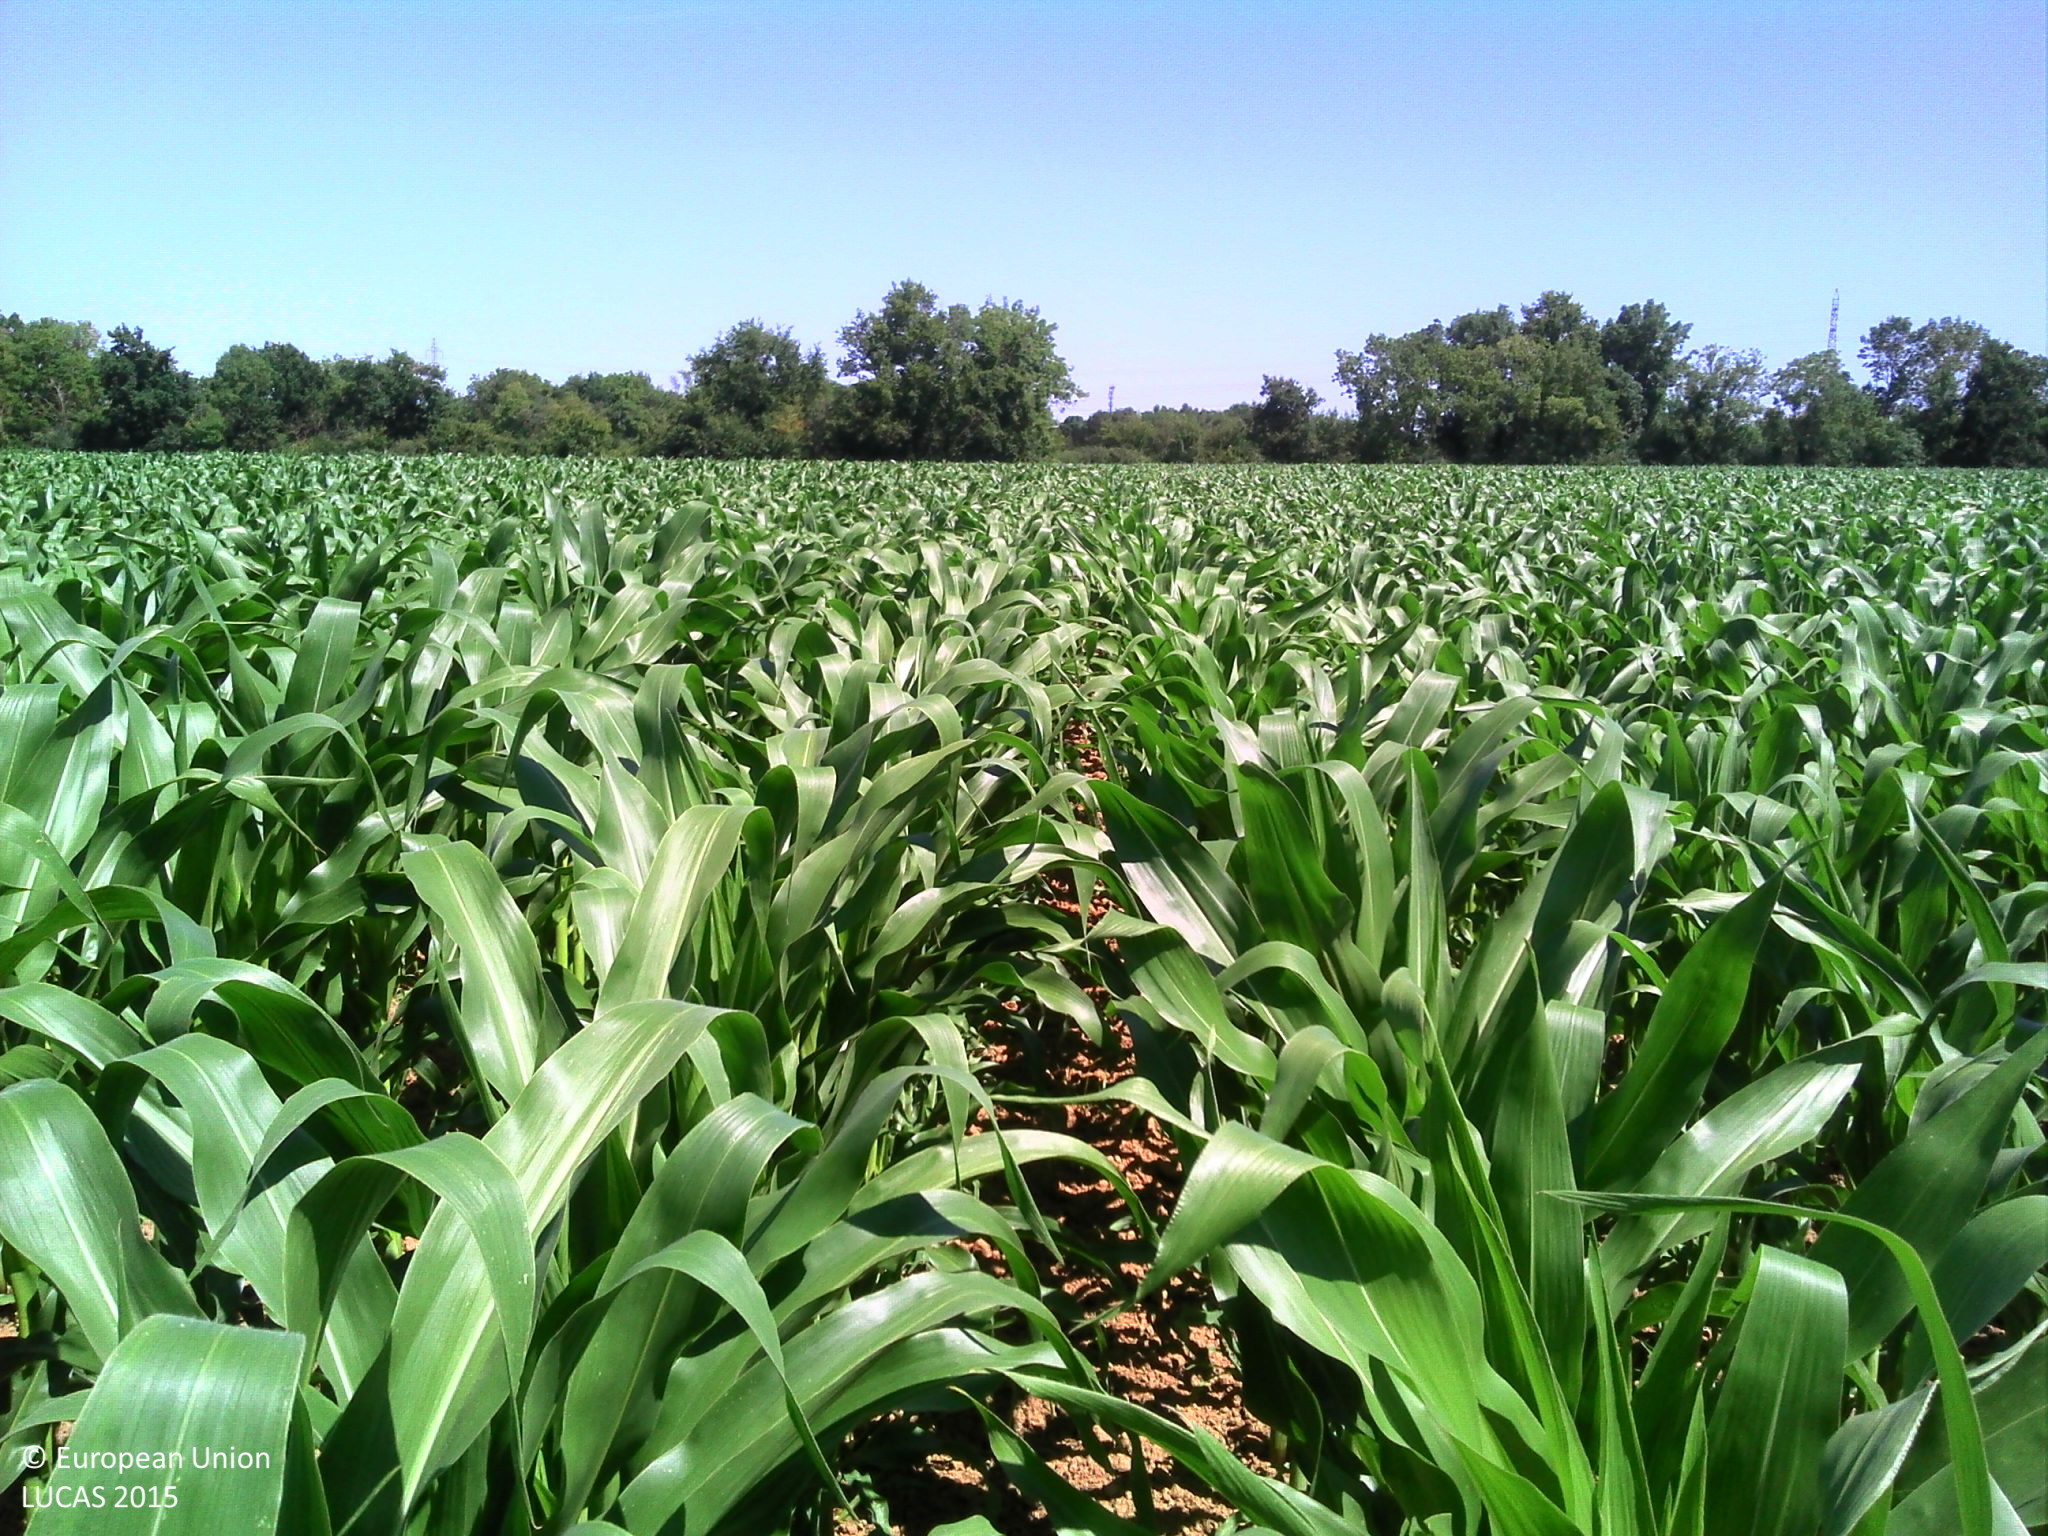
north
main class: Cropland
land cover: Maize
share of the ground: > 75 %
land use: Agriculture (excluding fallow land and kitchen gardens)
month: July
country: FR
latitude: 47.1776
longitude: -1.7216
